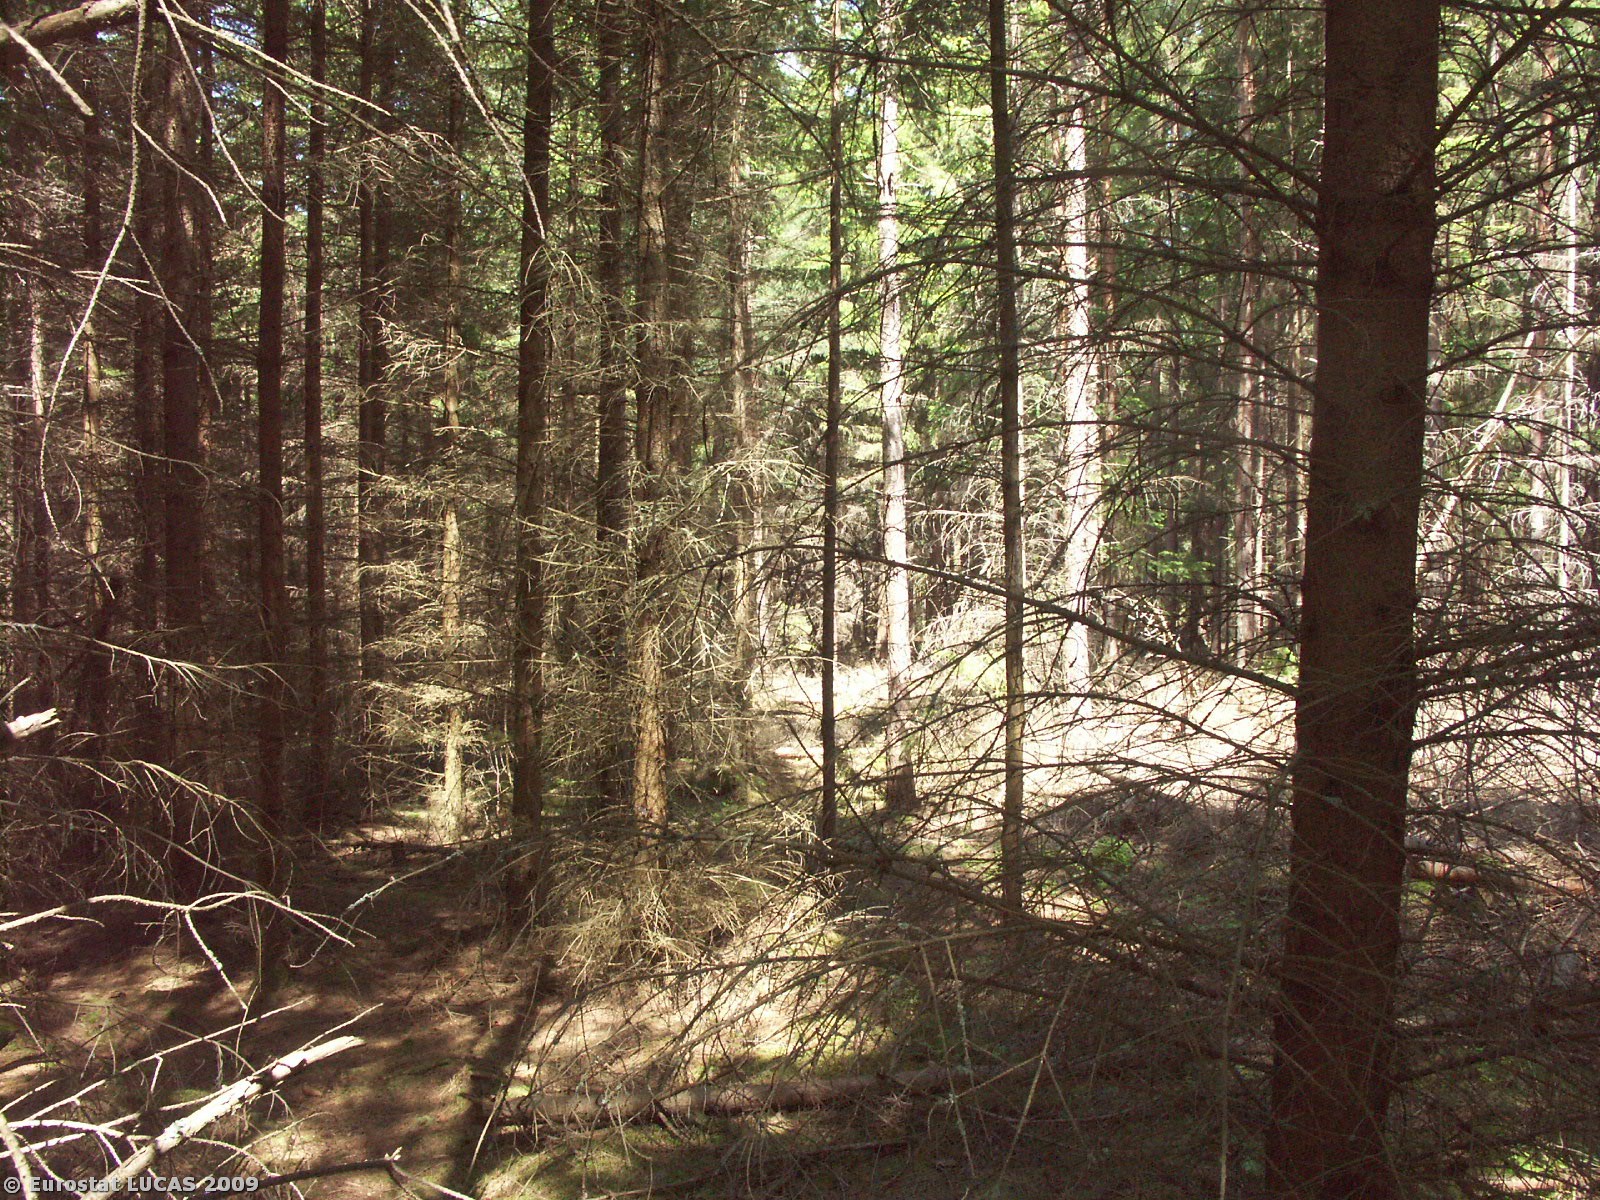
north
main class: Woodland
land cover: Coniferous woodland
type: hemiboreal forest and nemoral coniferous forest and mixed broadleaved-coniferous forest
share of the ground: > 75 %
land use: Forestry
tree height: > 5 m
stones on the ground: < 10 %
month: May
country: CZ
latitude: 48.8598
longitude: 14.7586
